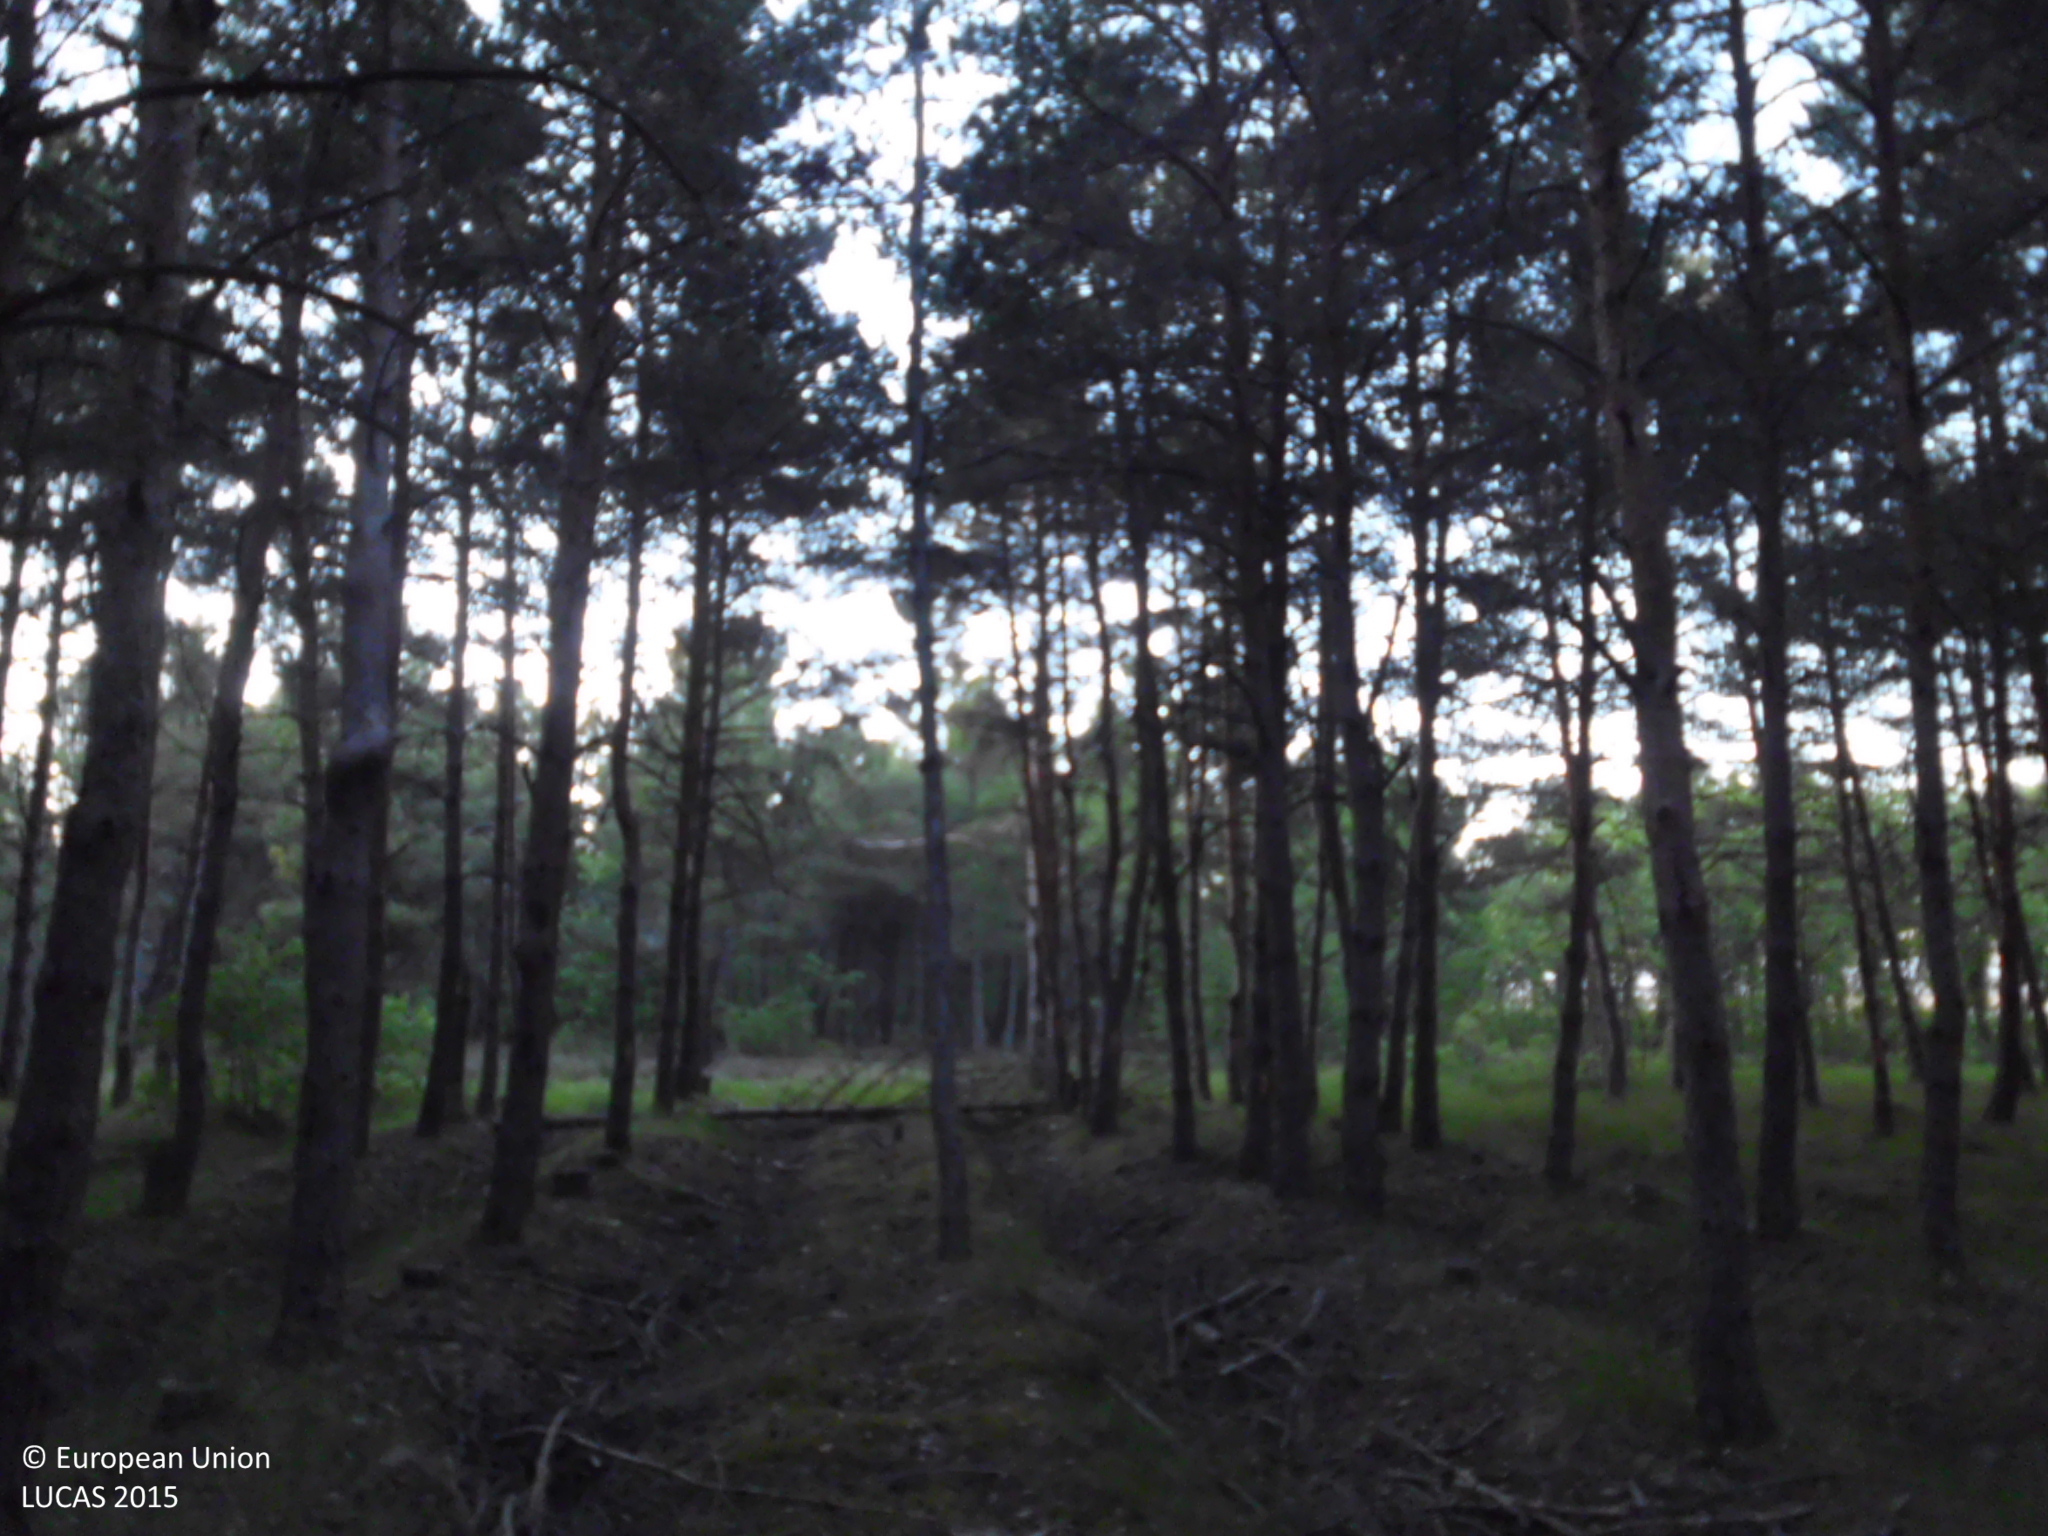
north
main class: Woodland
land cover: Pine dominated coniferous woodland
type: coniferous forest of the mediterranean region
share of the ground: > 75 %
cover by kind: coniferous forest trees 100 %
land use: Forestry
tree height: > 5 m
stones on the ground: > 50 %
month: May
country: ES
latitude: 42.5983
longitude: -4.8420
